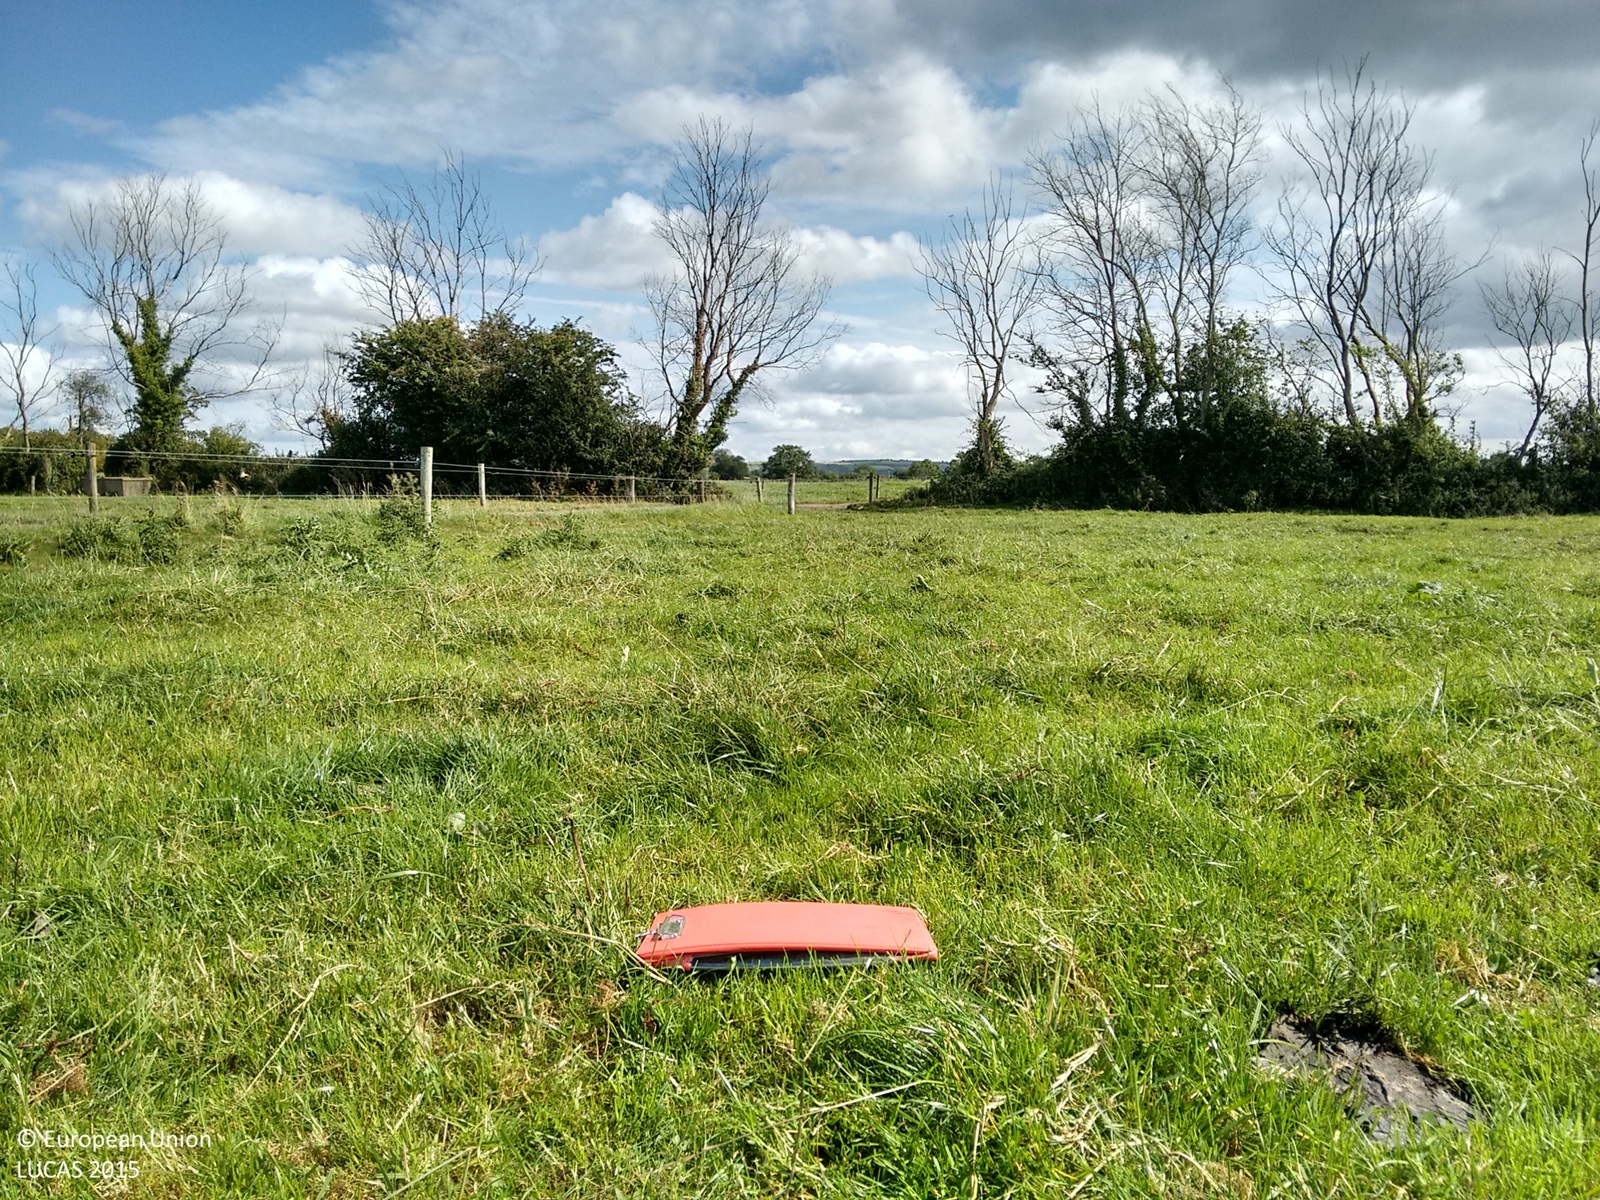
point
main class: Grassland
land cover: Grassland without tree/shrub cover
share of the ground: > 75 %
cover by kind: herbaceous plants 100 %
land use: Agriculture (excluding fallow land and kitchen gardens)
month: August
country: IE
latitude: 52.7558
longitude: -7.3873
